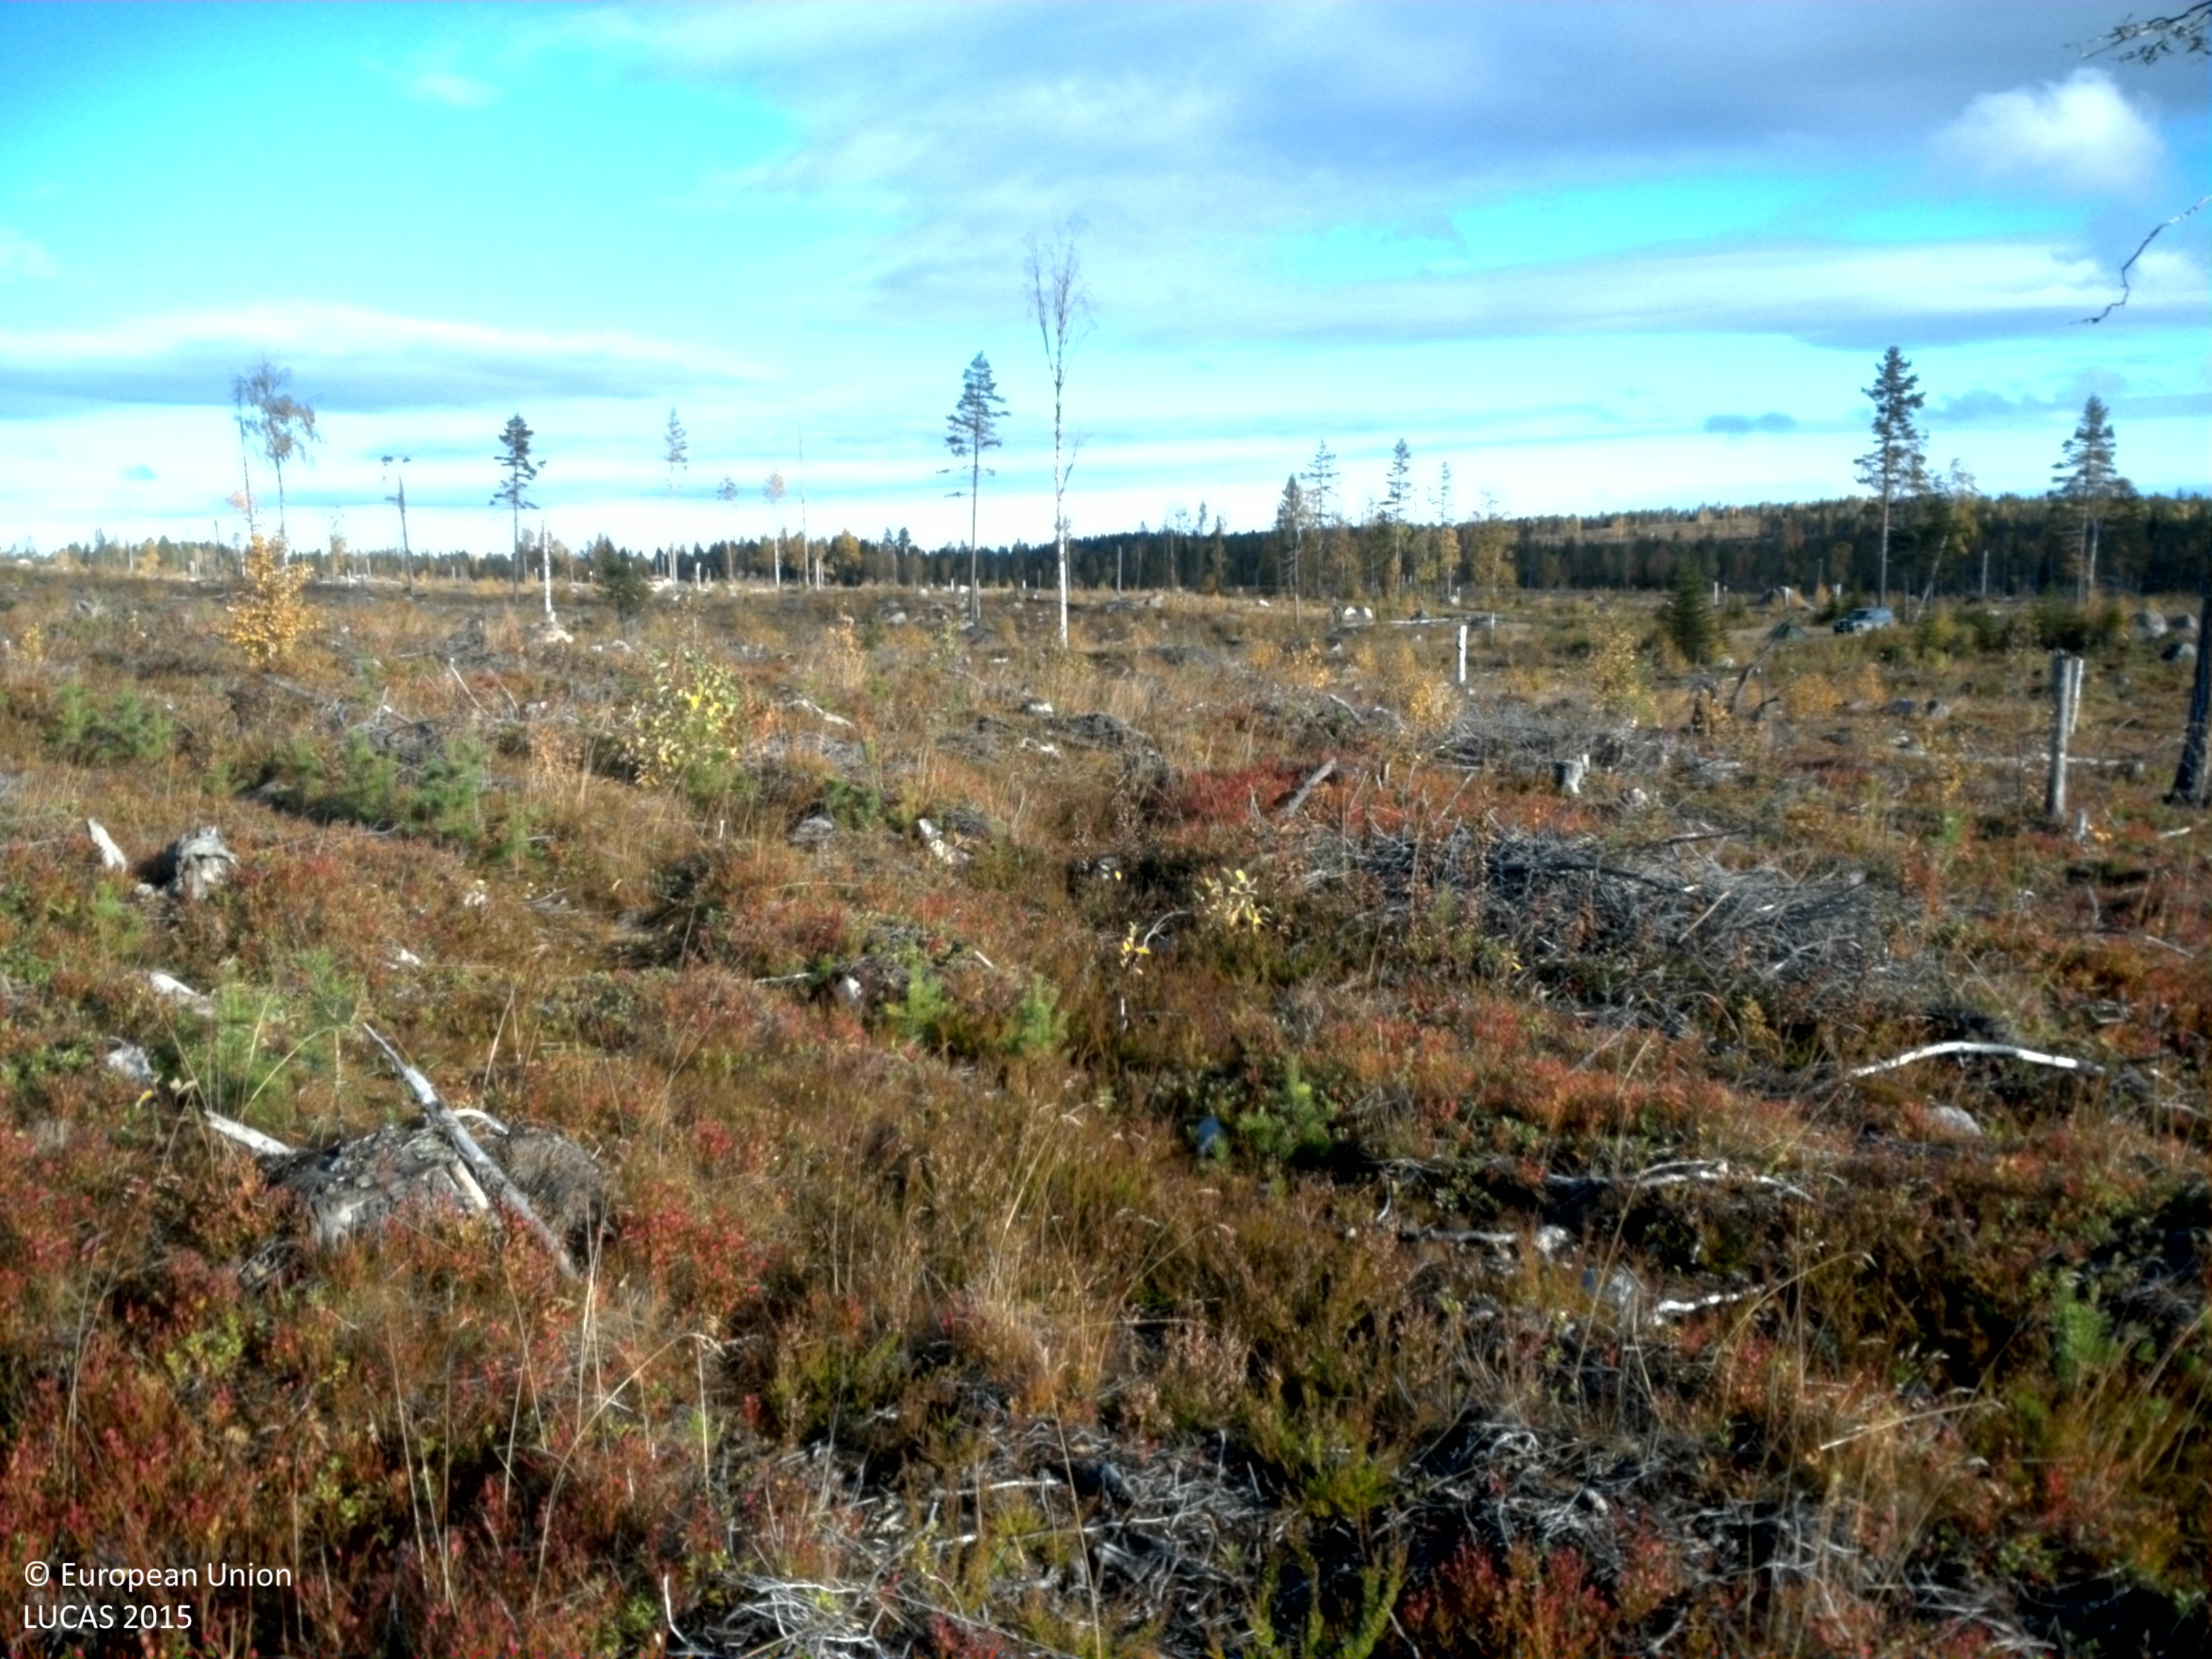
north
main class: Shrubland
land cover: Shrubland without tree cover
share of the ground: 50 - 75 %
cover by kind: shrubs 60 %, herbaceous plants 20 %, unconsolidated bare surface 10 %, lichens and mosses 5 %
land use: Forestry
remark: Clear cut
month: September
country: SE
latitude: 65.0198
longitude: 17.8794
